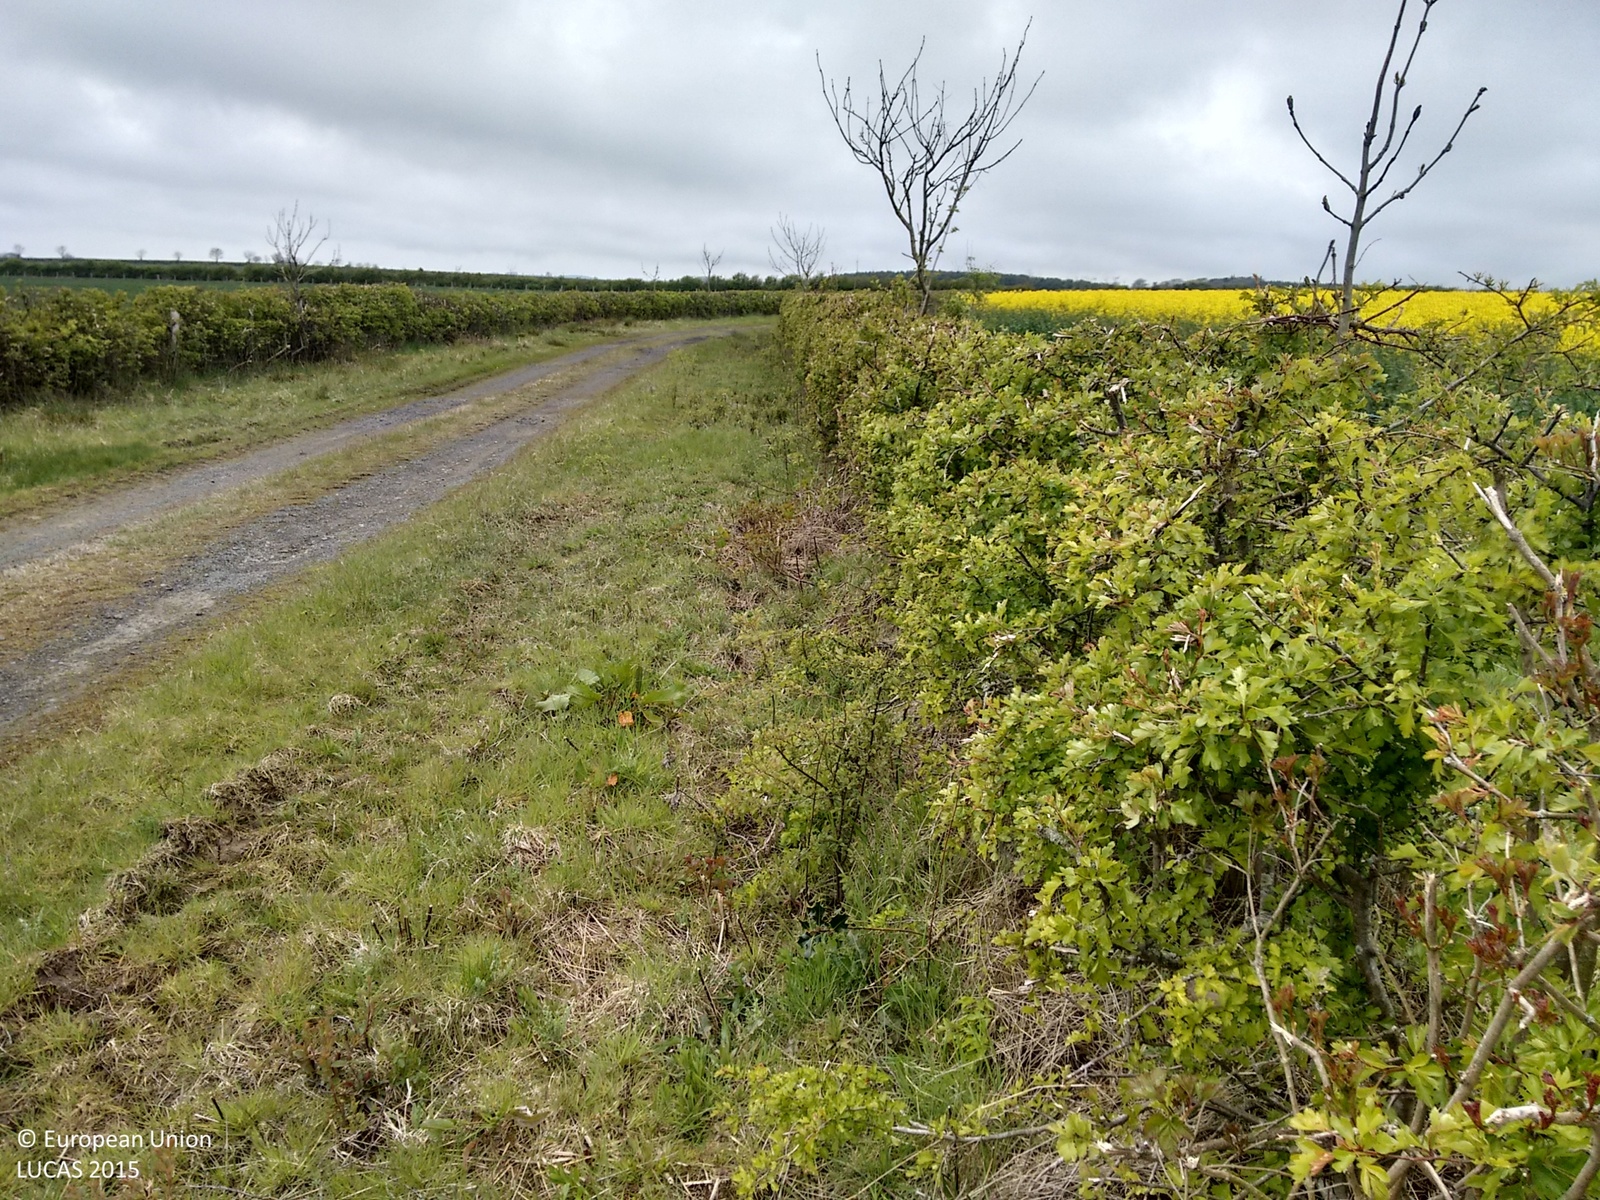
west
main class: Cropland
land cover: Rape and turnip rape
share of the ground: > 75 %
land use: Agriculture (excluding fallow land and kitchen gardens)
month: May
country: GB
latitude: 55.2790
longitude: -1.5870
